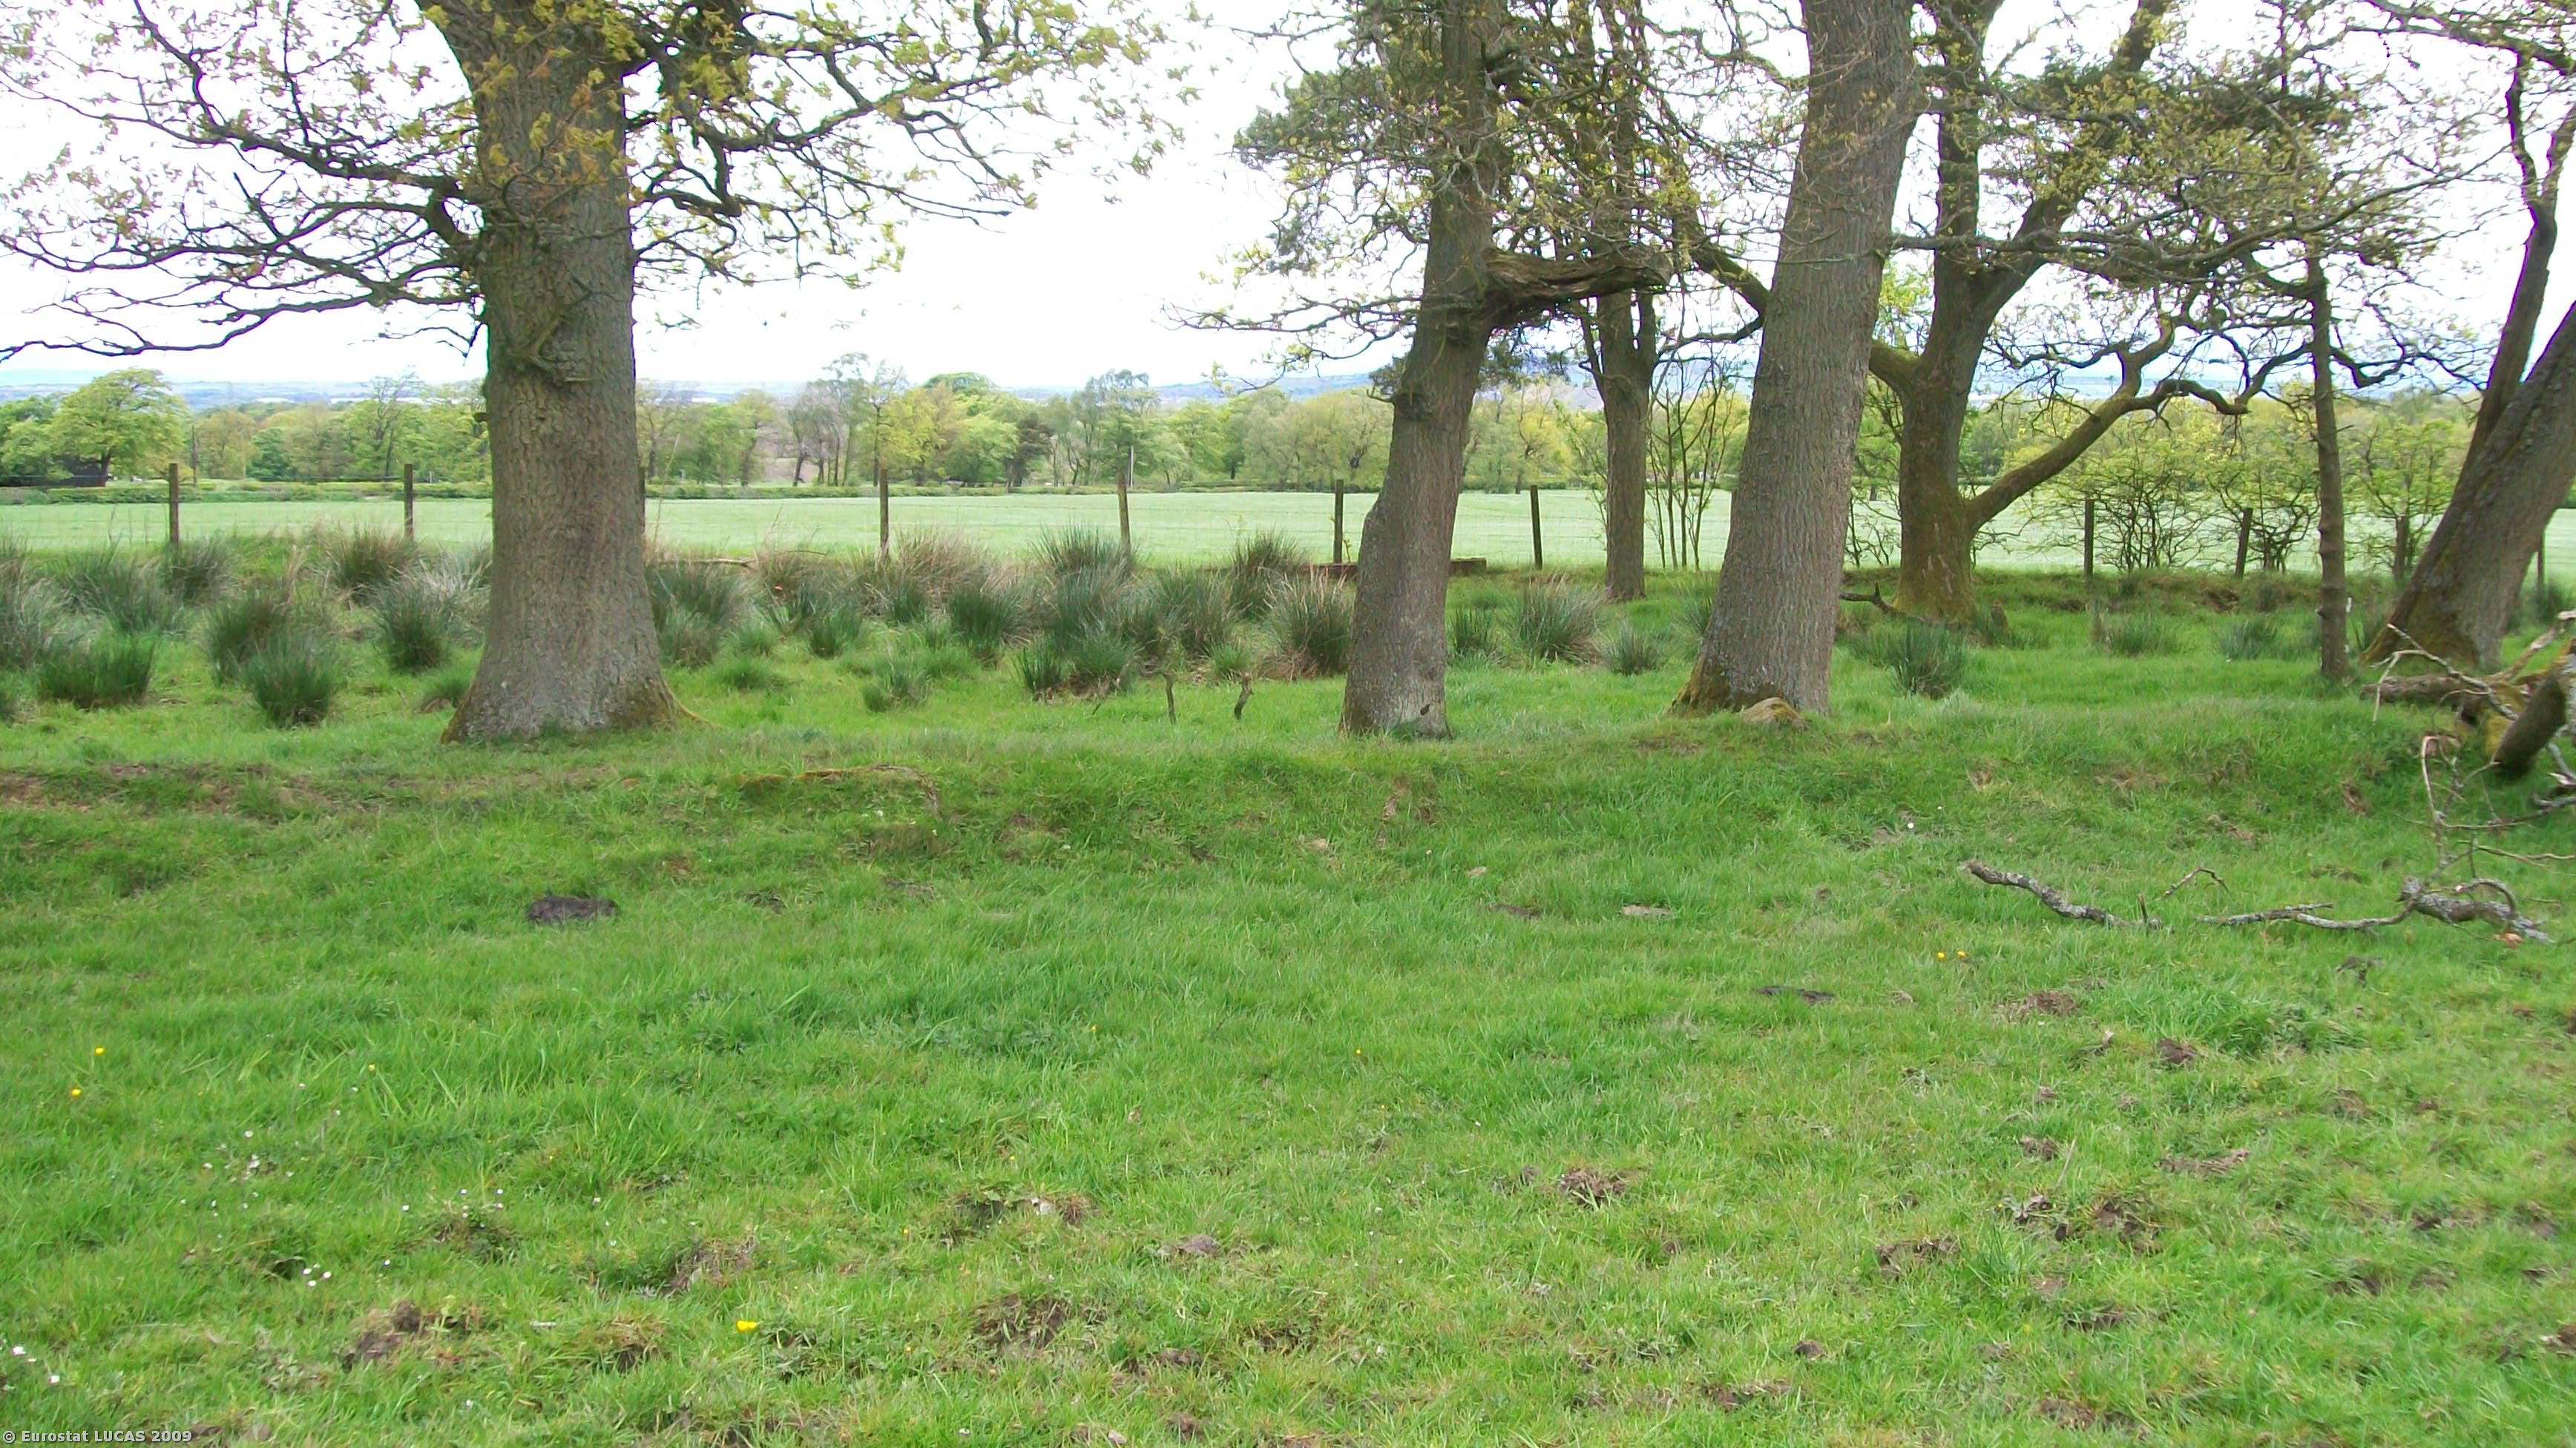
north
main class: Grassland
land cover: Grassland without tree/shrub cover
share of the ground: > 75 %
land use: Agriculture (excluding fallow land and kitchen gardens)
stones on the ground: < 10 %
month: May
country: GB
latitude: 55.8278
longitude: -3.5685
